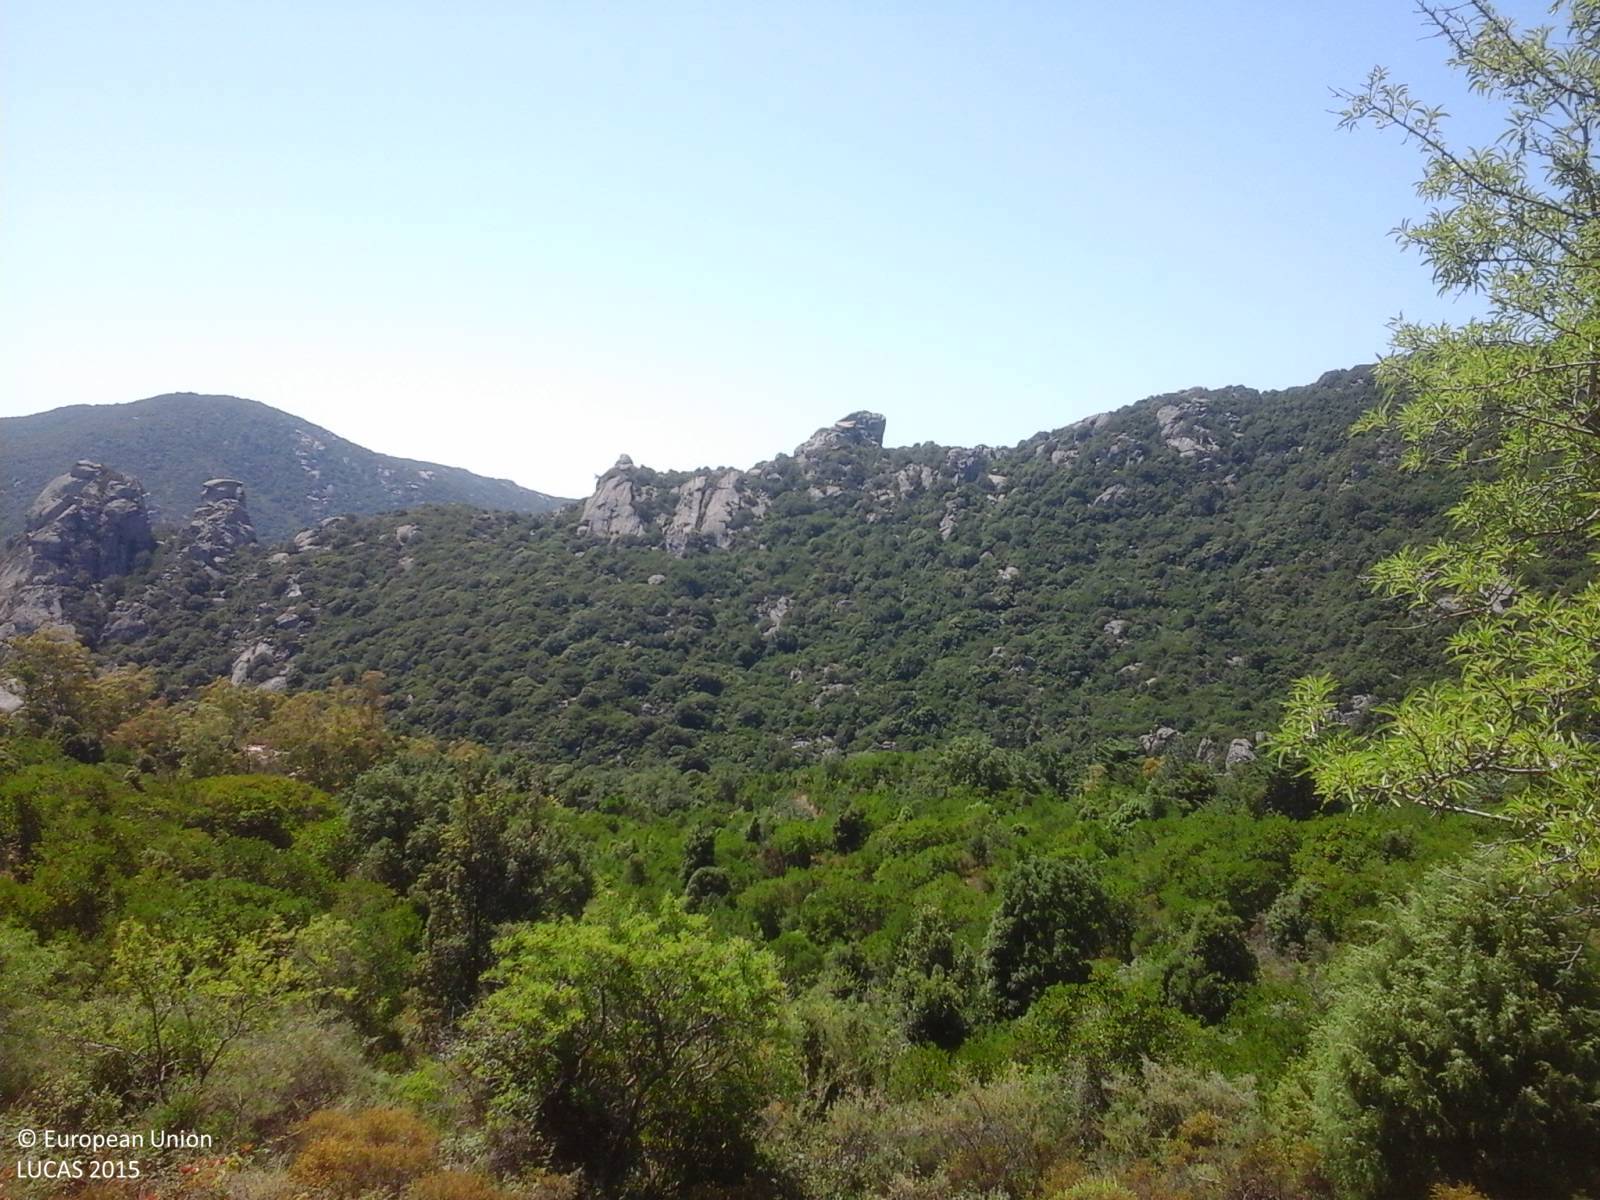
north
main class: Shrubland
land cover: Shrubland with sparse tree cover
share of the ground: > 75 %
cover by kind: shrubs 55 %, herbaceous plants 30 %, unconsolidated bare surface 10 %, broadleaved forest trees 5 %
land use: Semi-natural and natural areas not in use
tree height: < 5 m
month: June
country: IT
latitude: 39.2513
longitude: 9.4127
